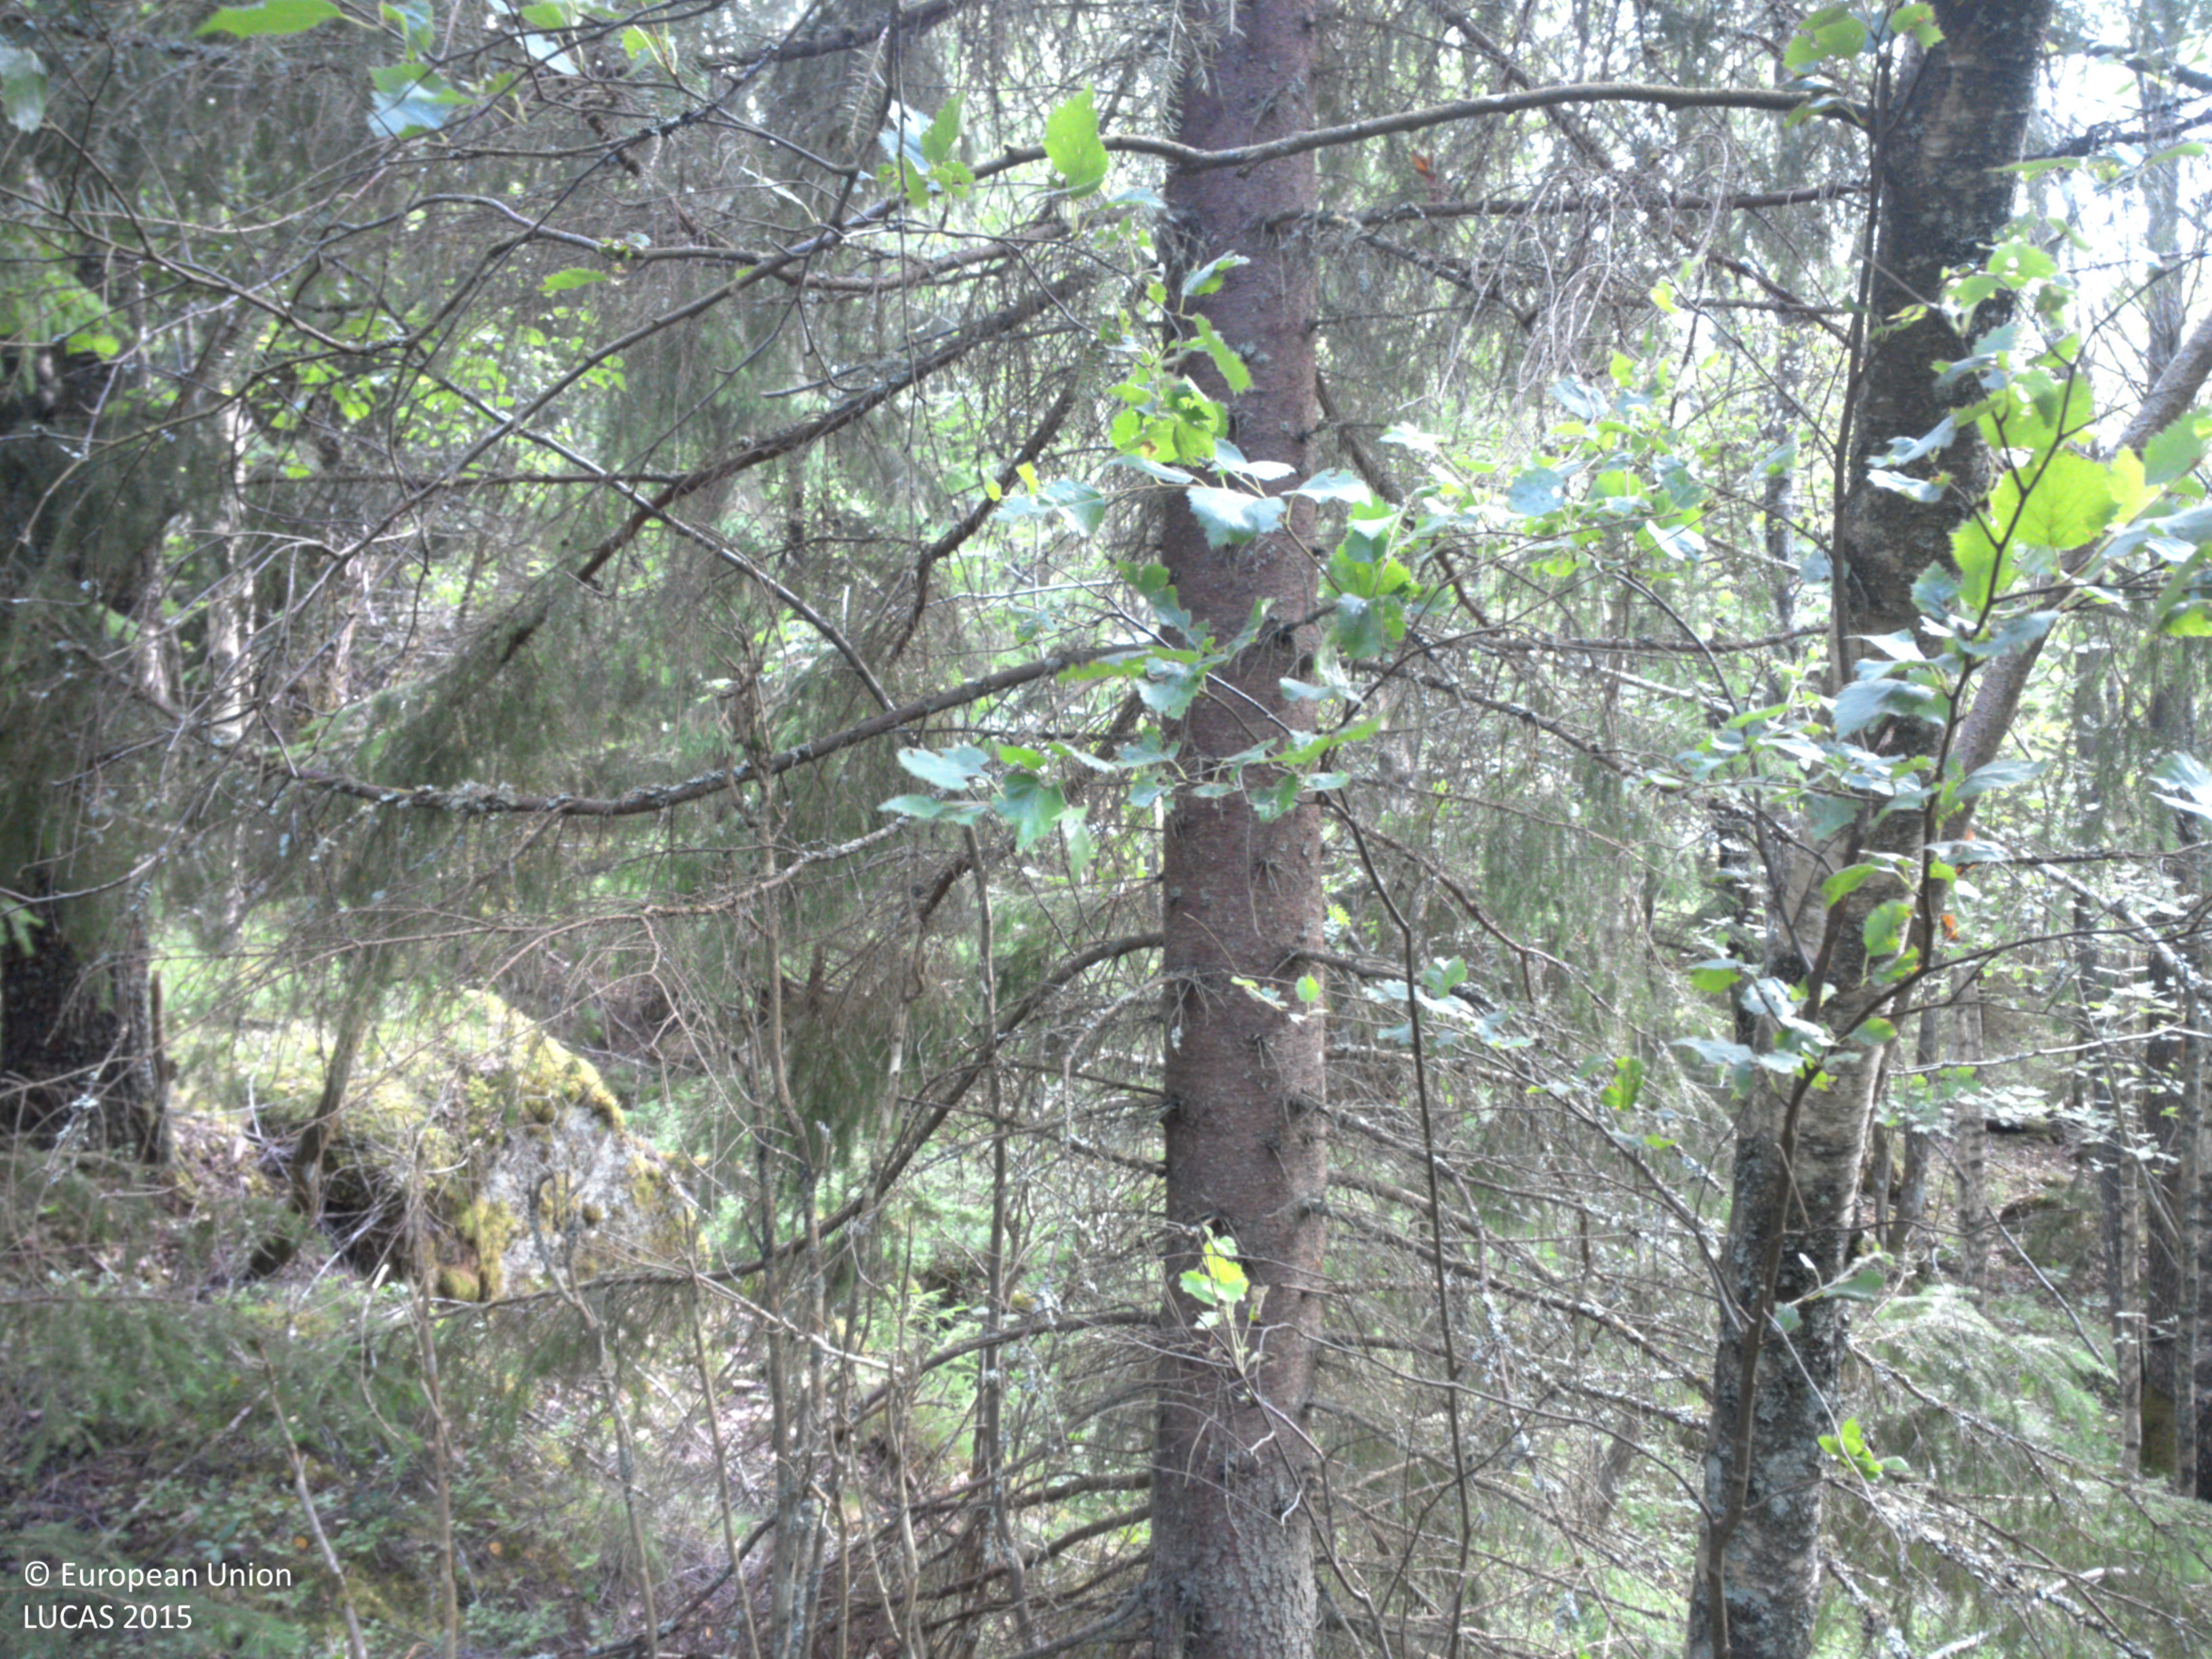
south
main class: Woodland
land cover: Spruce dominated mixed woodland
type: boreal forest
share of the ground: 50 - 75 %
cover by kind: coniferous forest trees 45 %, herbaceous plants 30 %, broadleaved forest trees 25 %
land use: Forestry
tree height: > 5 m
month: July
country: SE
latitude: 58.7441
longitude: 12.0172
